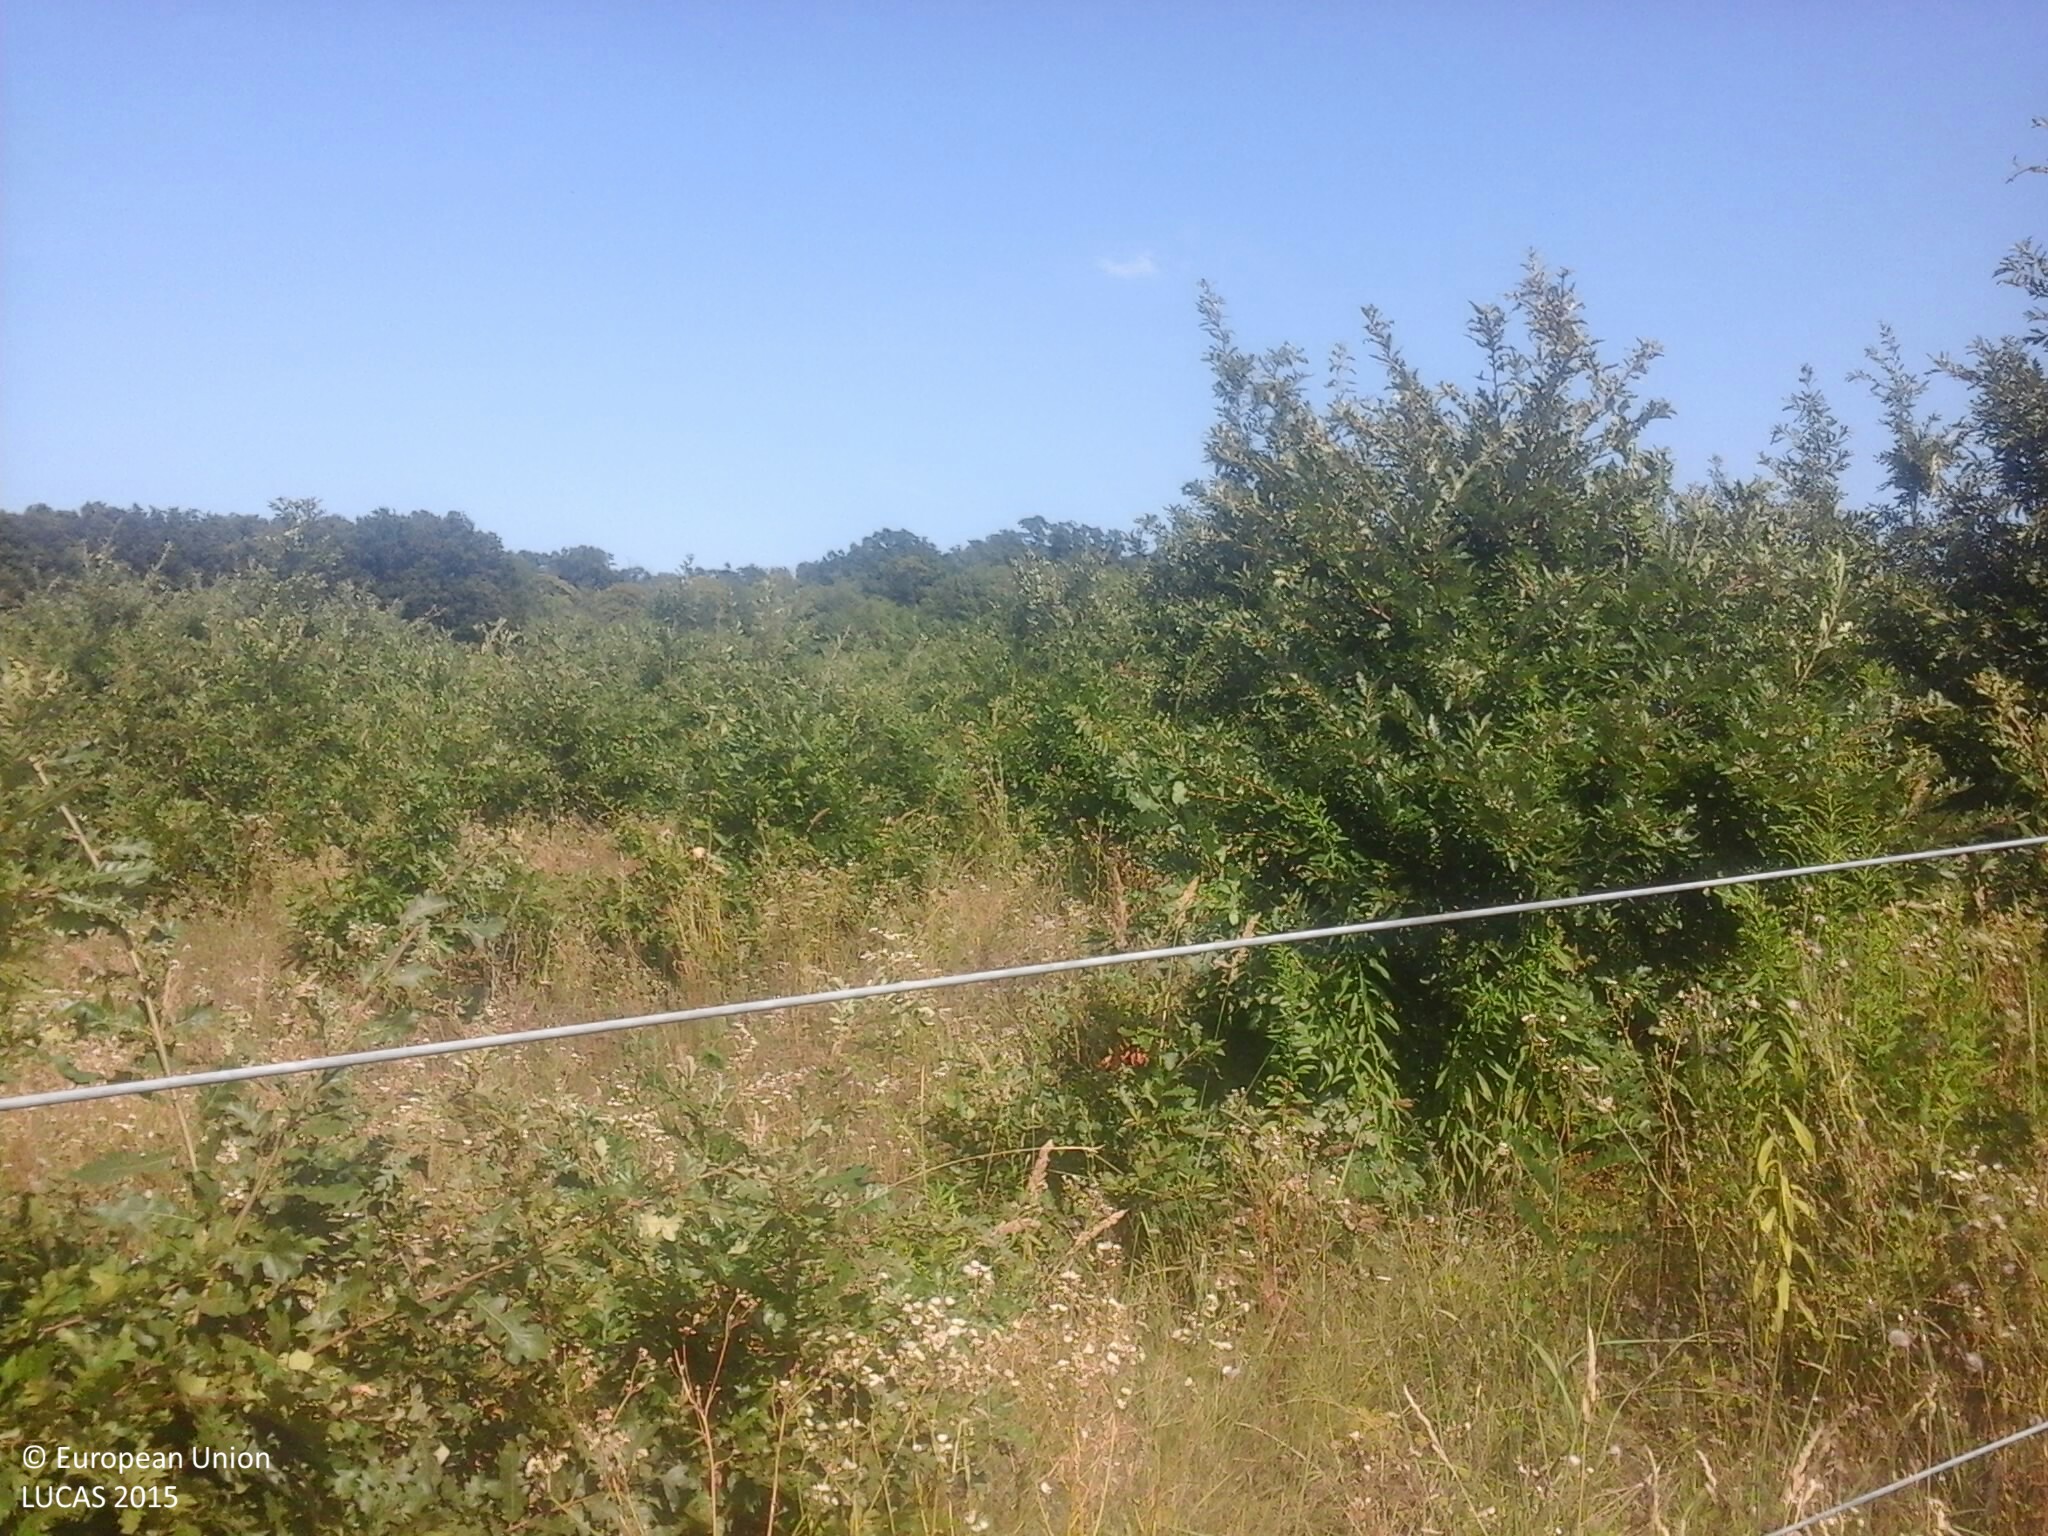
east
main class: Woodland
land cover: Broadleaved woodland
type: mesophytic deciduous forest
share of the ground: > 75 %
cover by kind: broadleaved forest trees 80 %, herbaceous plants 20 %
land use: Forestry
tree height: < 5 m
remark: Nursery
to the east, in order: Broadleaved woodland; Fences; Grass margins; Tracks; Grass margins; Broadleaved woodland
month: August
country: HU
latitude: 46.8535
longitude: 17.9168
